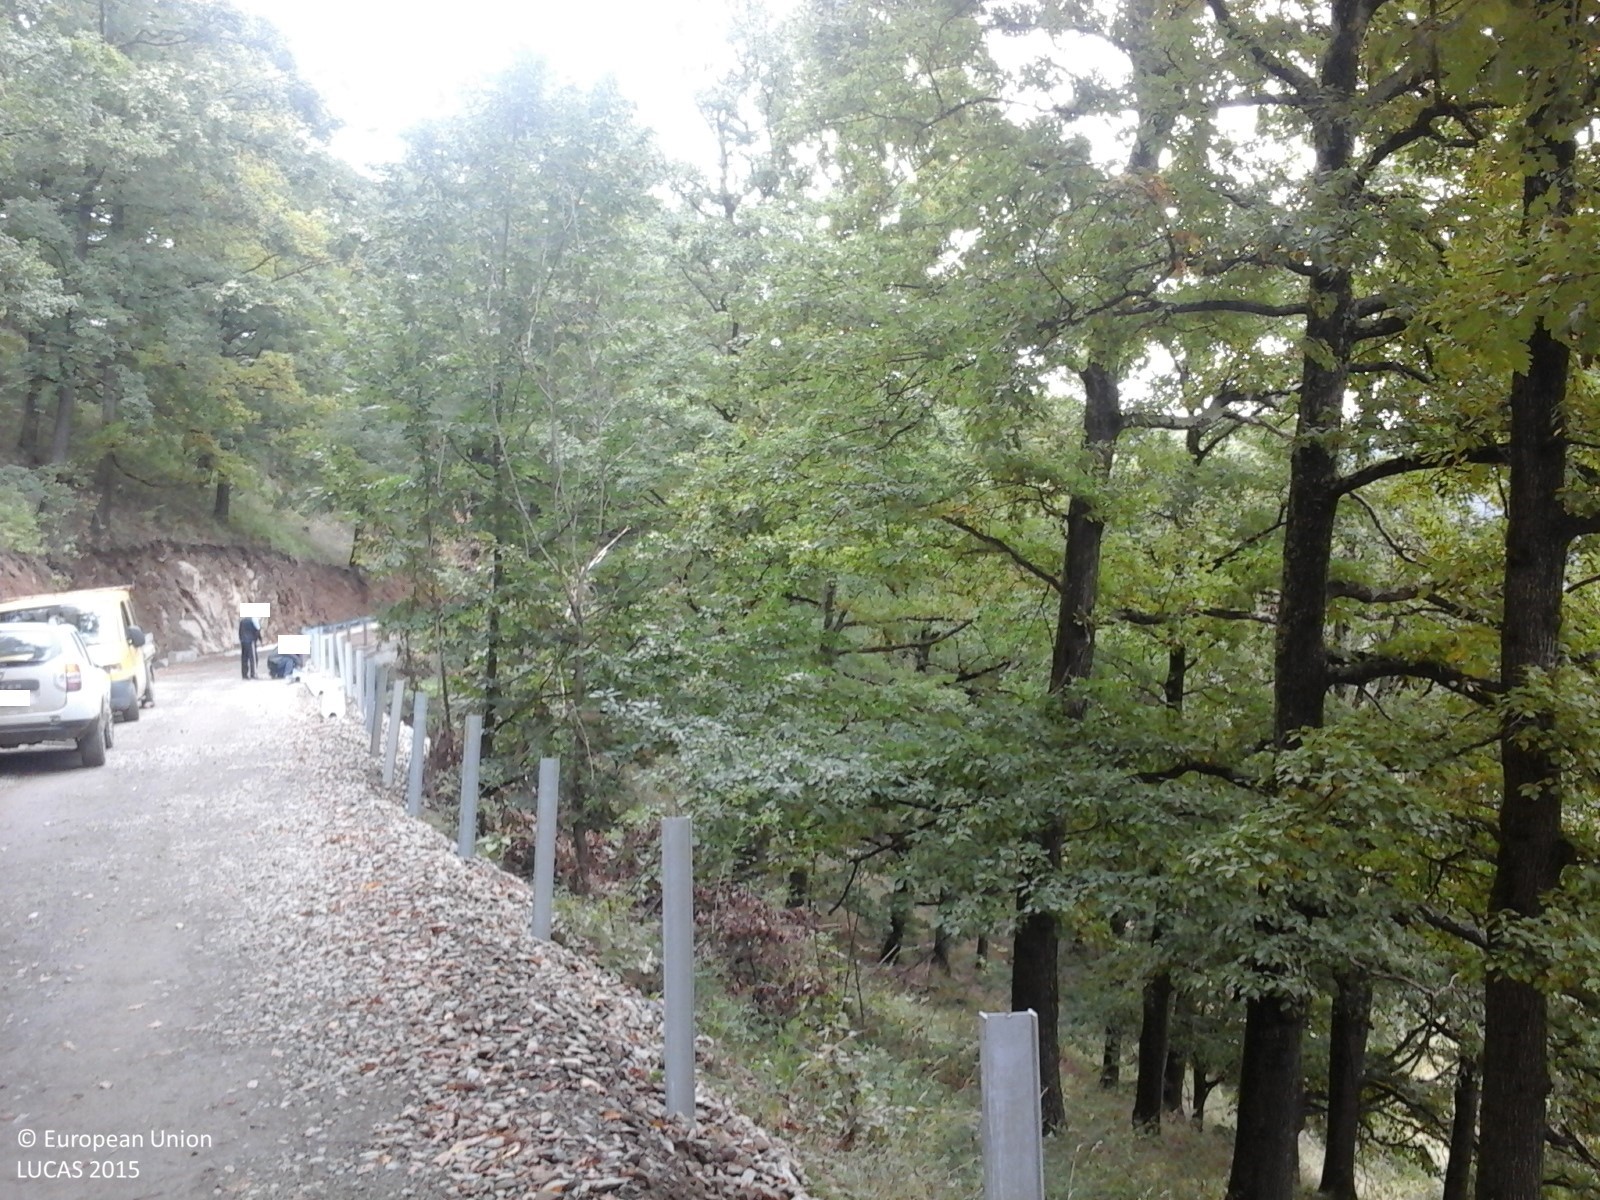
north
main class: Woodland
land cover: Broadleaved woodland
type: acidophilous oak and oak-birch forest
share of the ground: > 75 %
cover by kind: broadleaved forest trees 100 %
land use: Forestry
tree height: > 5 m
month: September
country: RO
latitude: 45.7659
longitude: 23.6307
